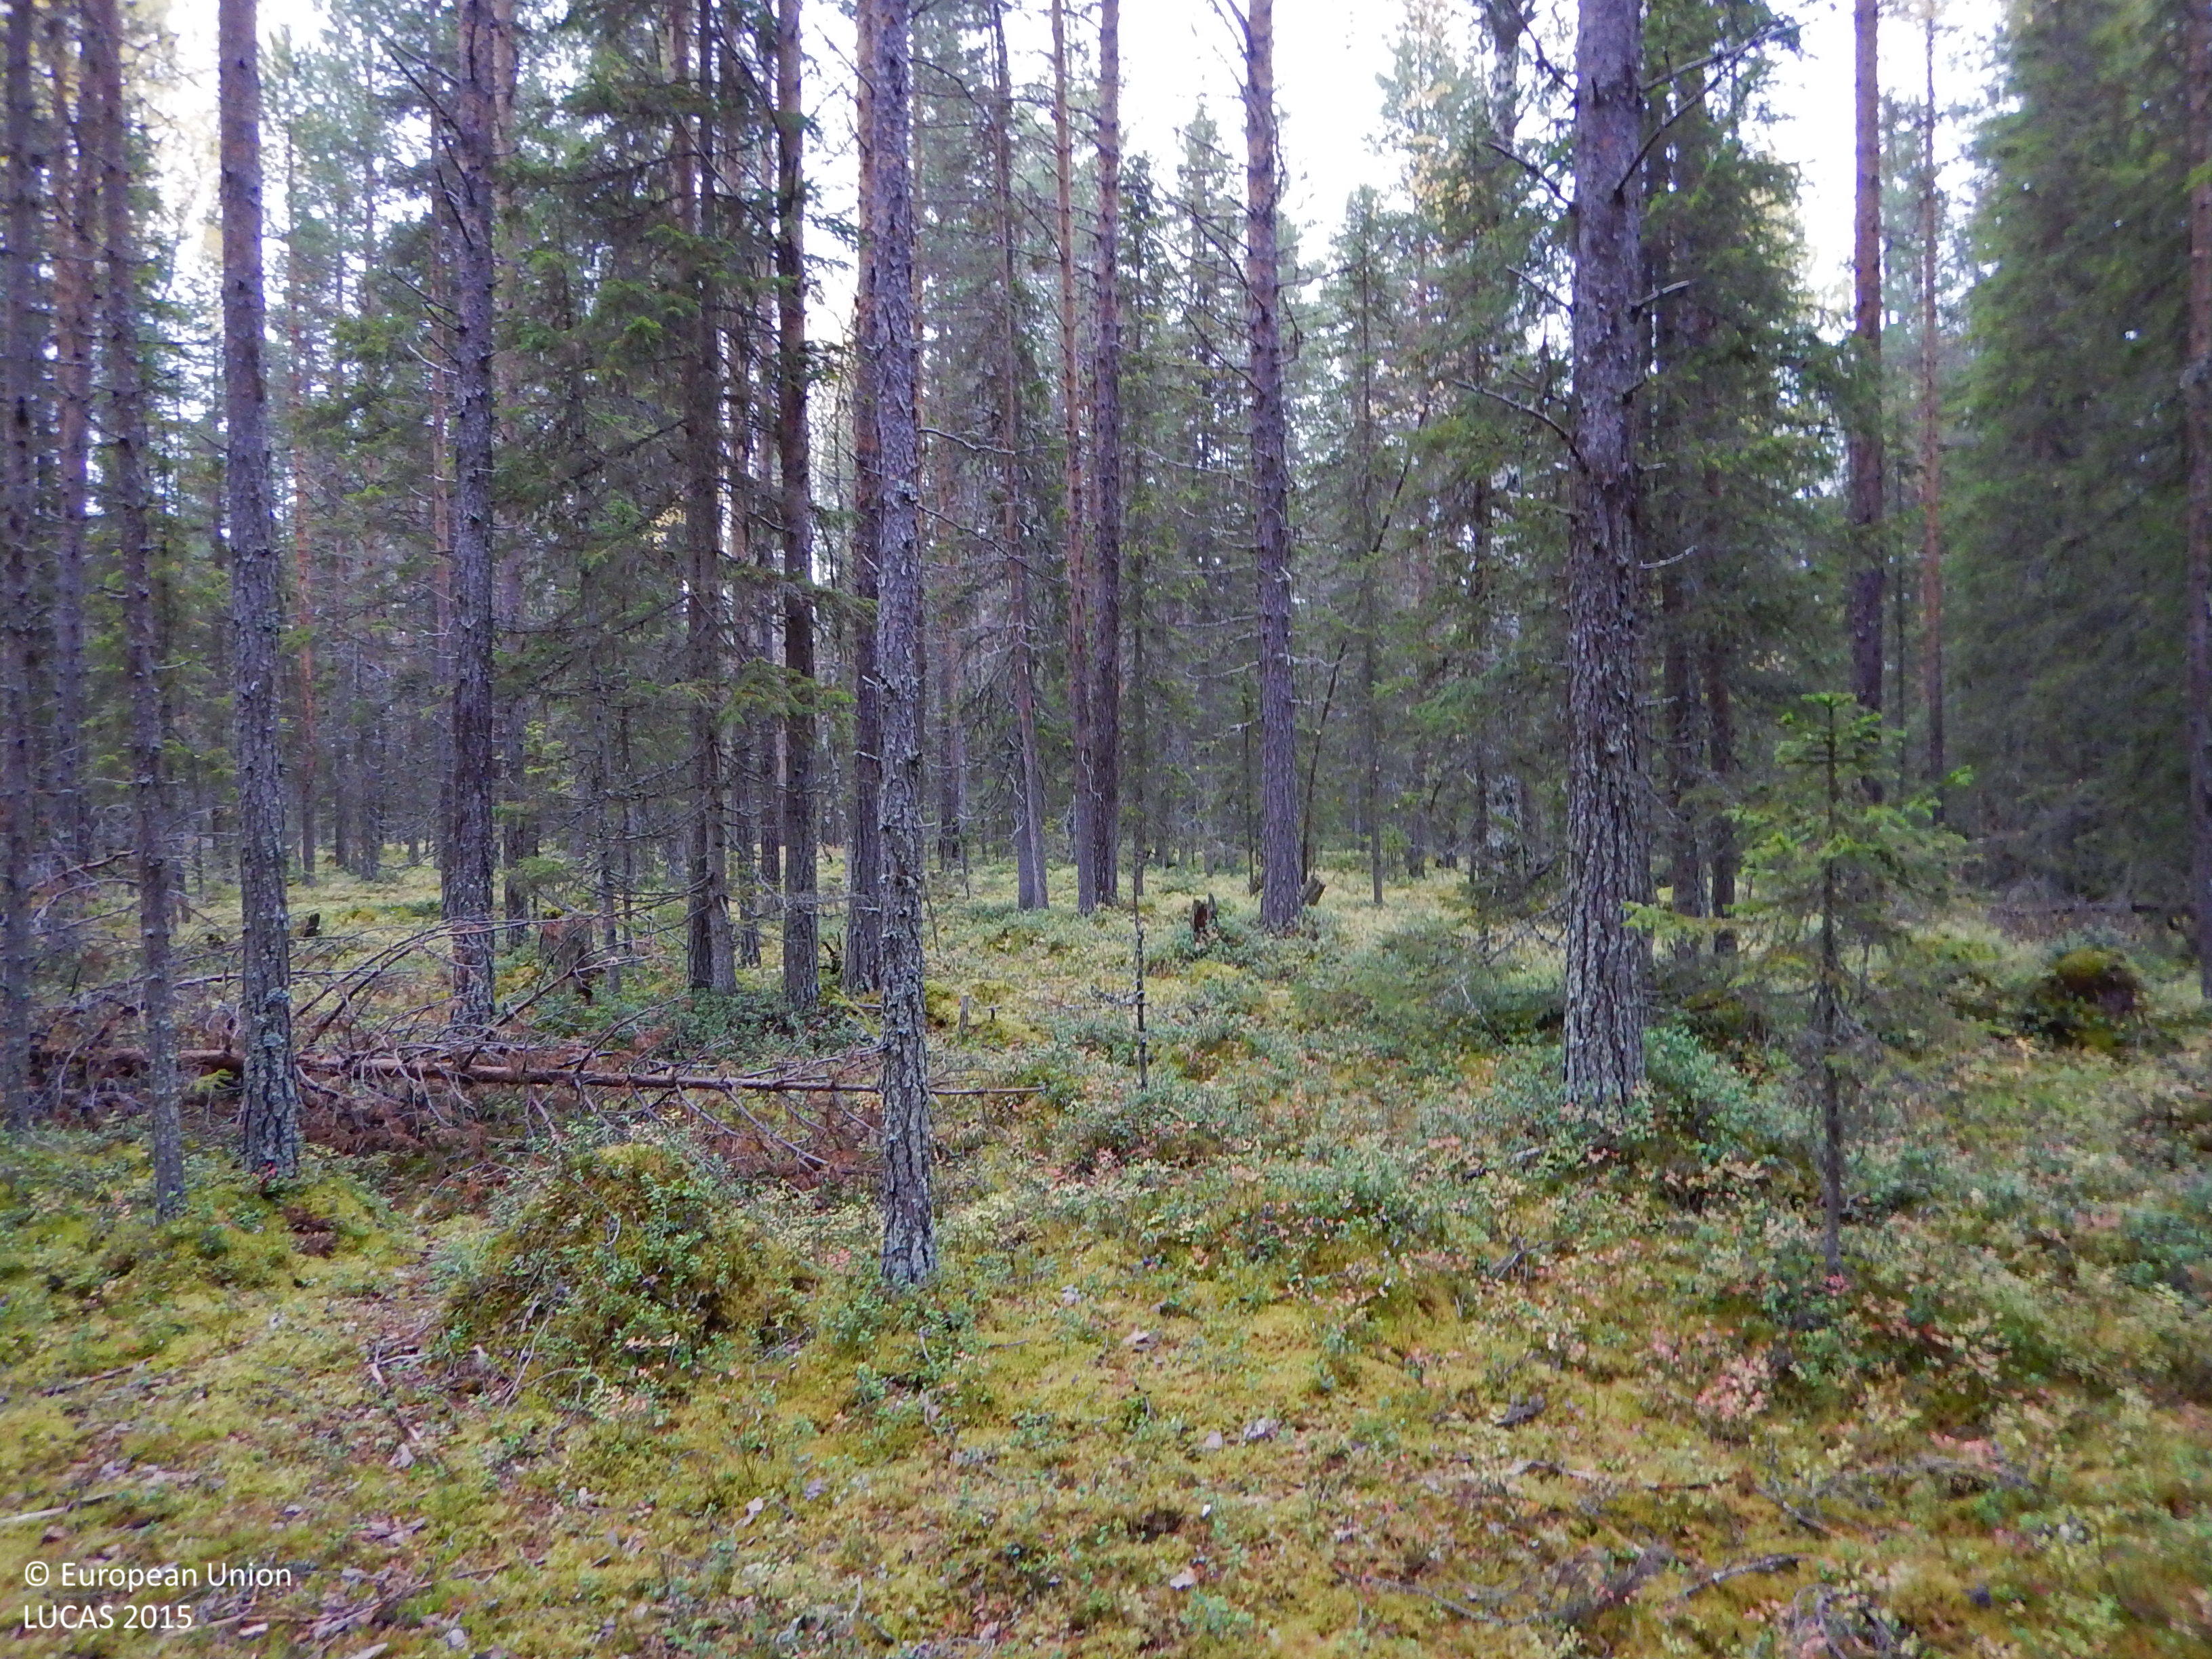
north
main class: Woodland
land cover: Pine dominated coniferous woodland
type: boreal forest
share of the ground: 50 - 75 %
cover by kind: coniferous forest trees 60 %, shrubs 15 %, lichens and mosses 15 %, herbaceous plants 10 %
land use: Forestry
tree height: > 5 m
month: September
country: SE
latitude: 65.0540
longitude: 19.2944
